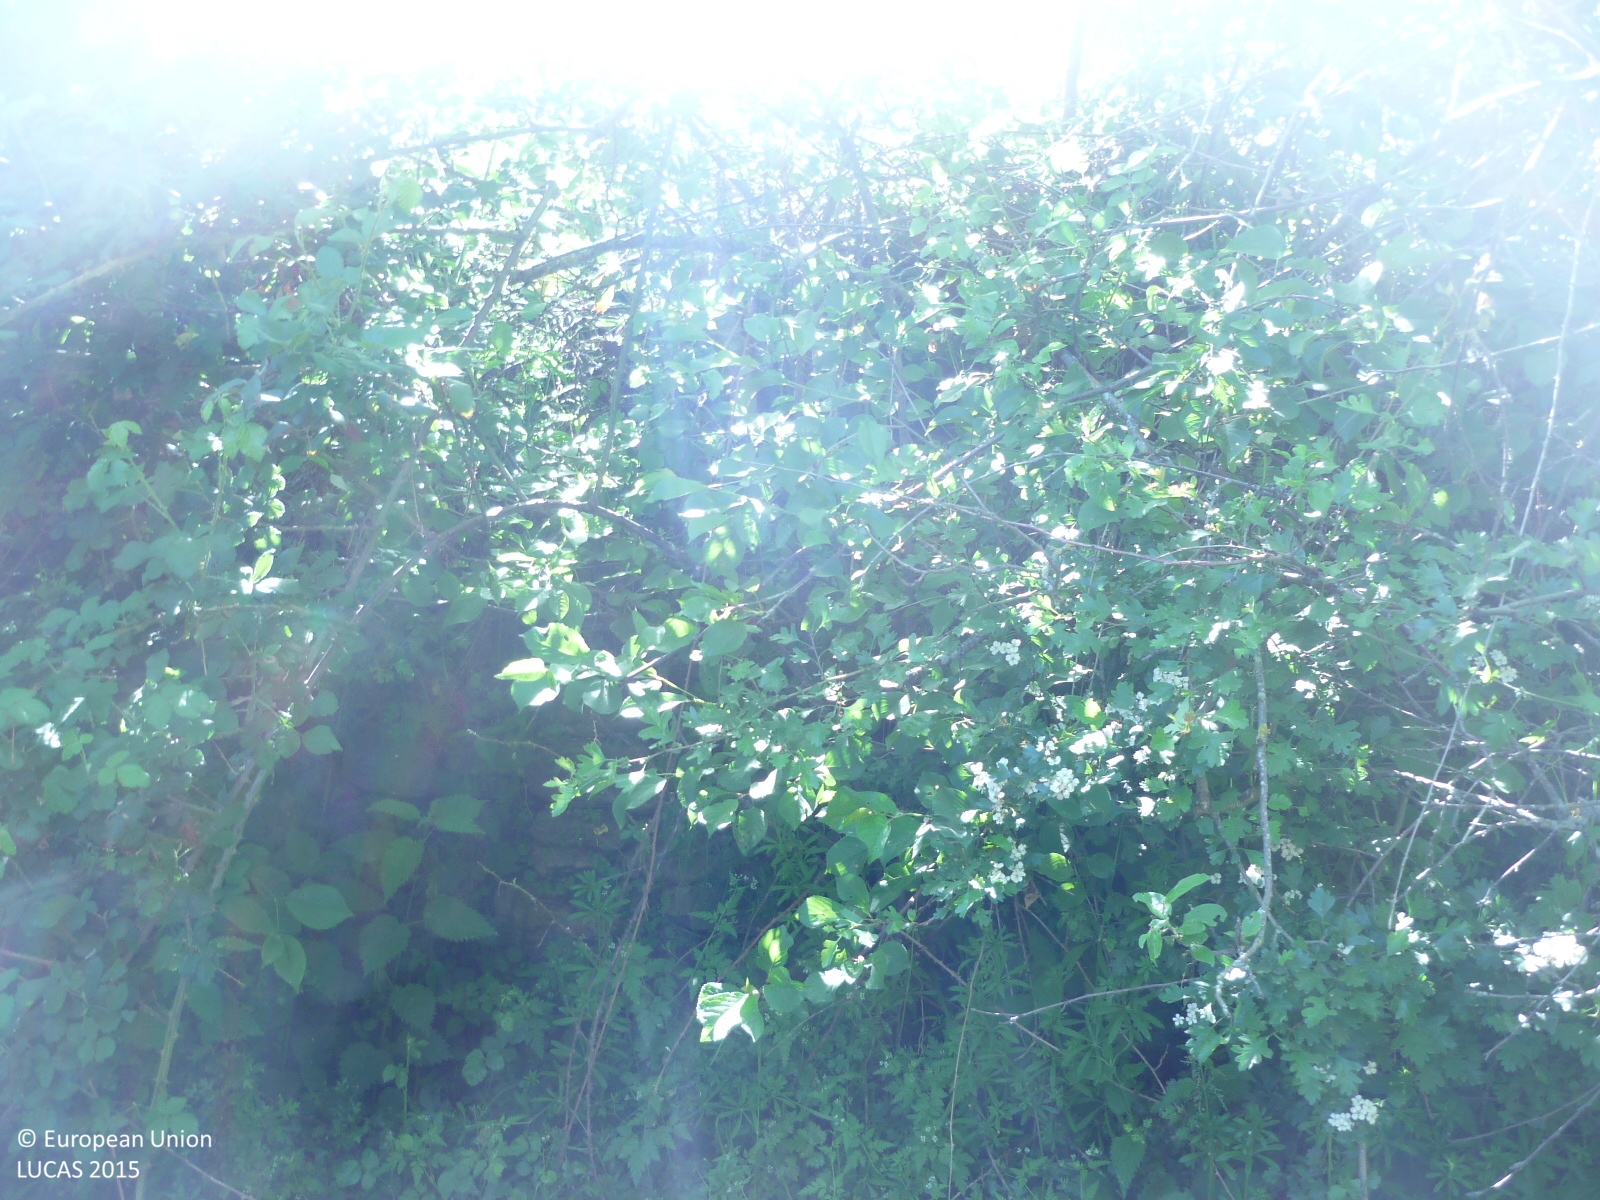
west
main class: Grassland
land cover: Grassland without tree/shrub cover
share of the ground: > 75 %
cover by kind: herbaceous plants 95 %, shrubs 5 %
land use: Agriculture (excluding fallow land and kitchen gardens)
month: May
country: ES
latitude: 41.1555
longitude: -3.4011
